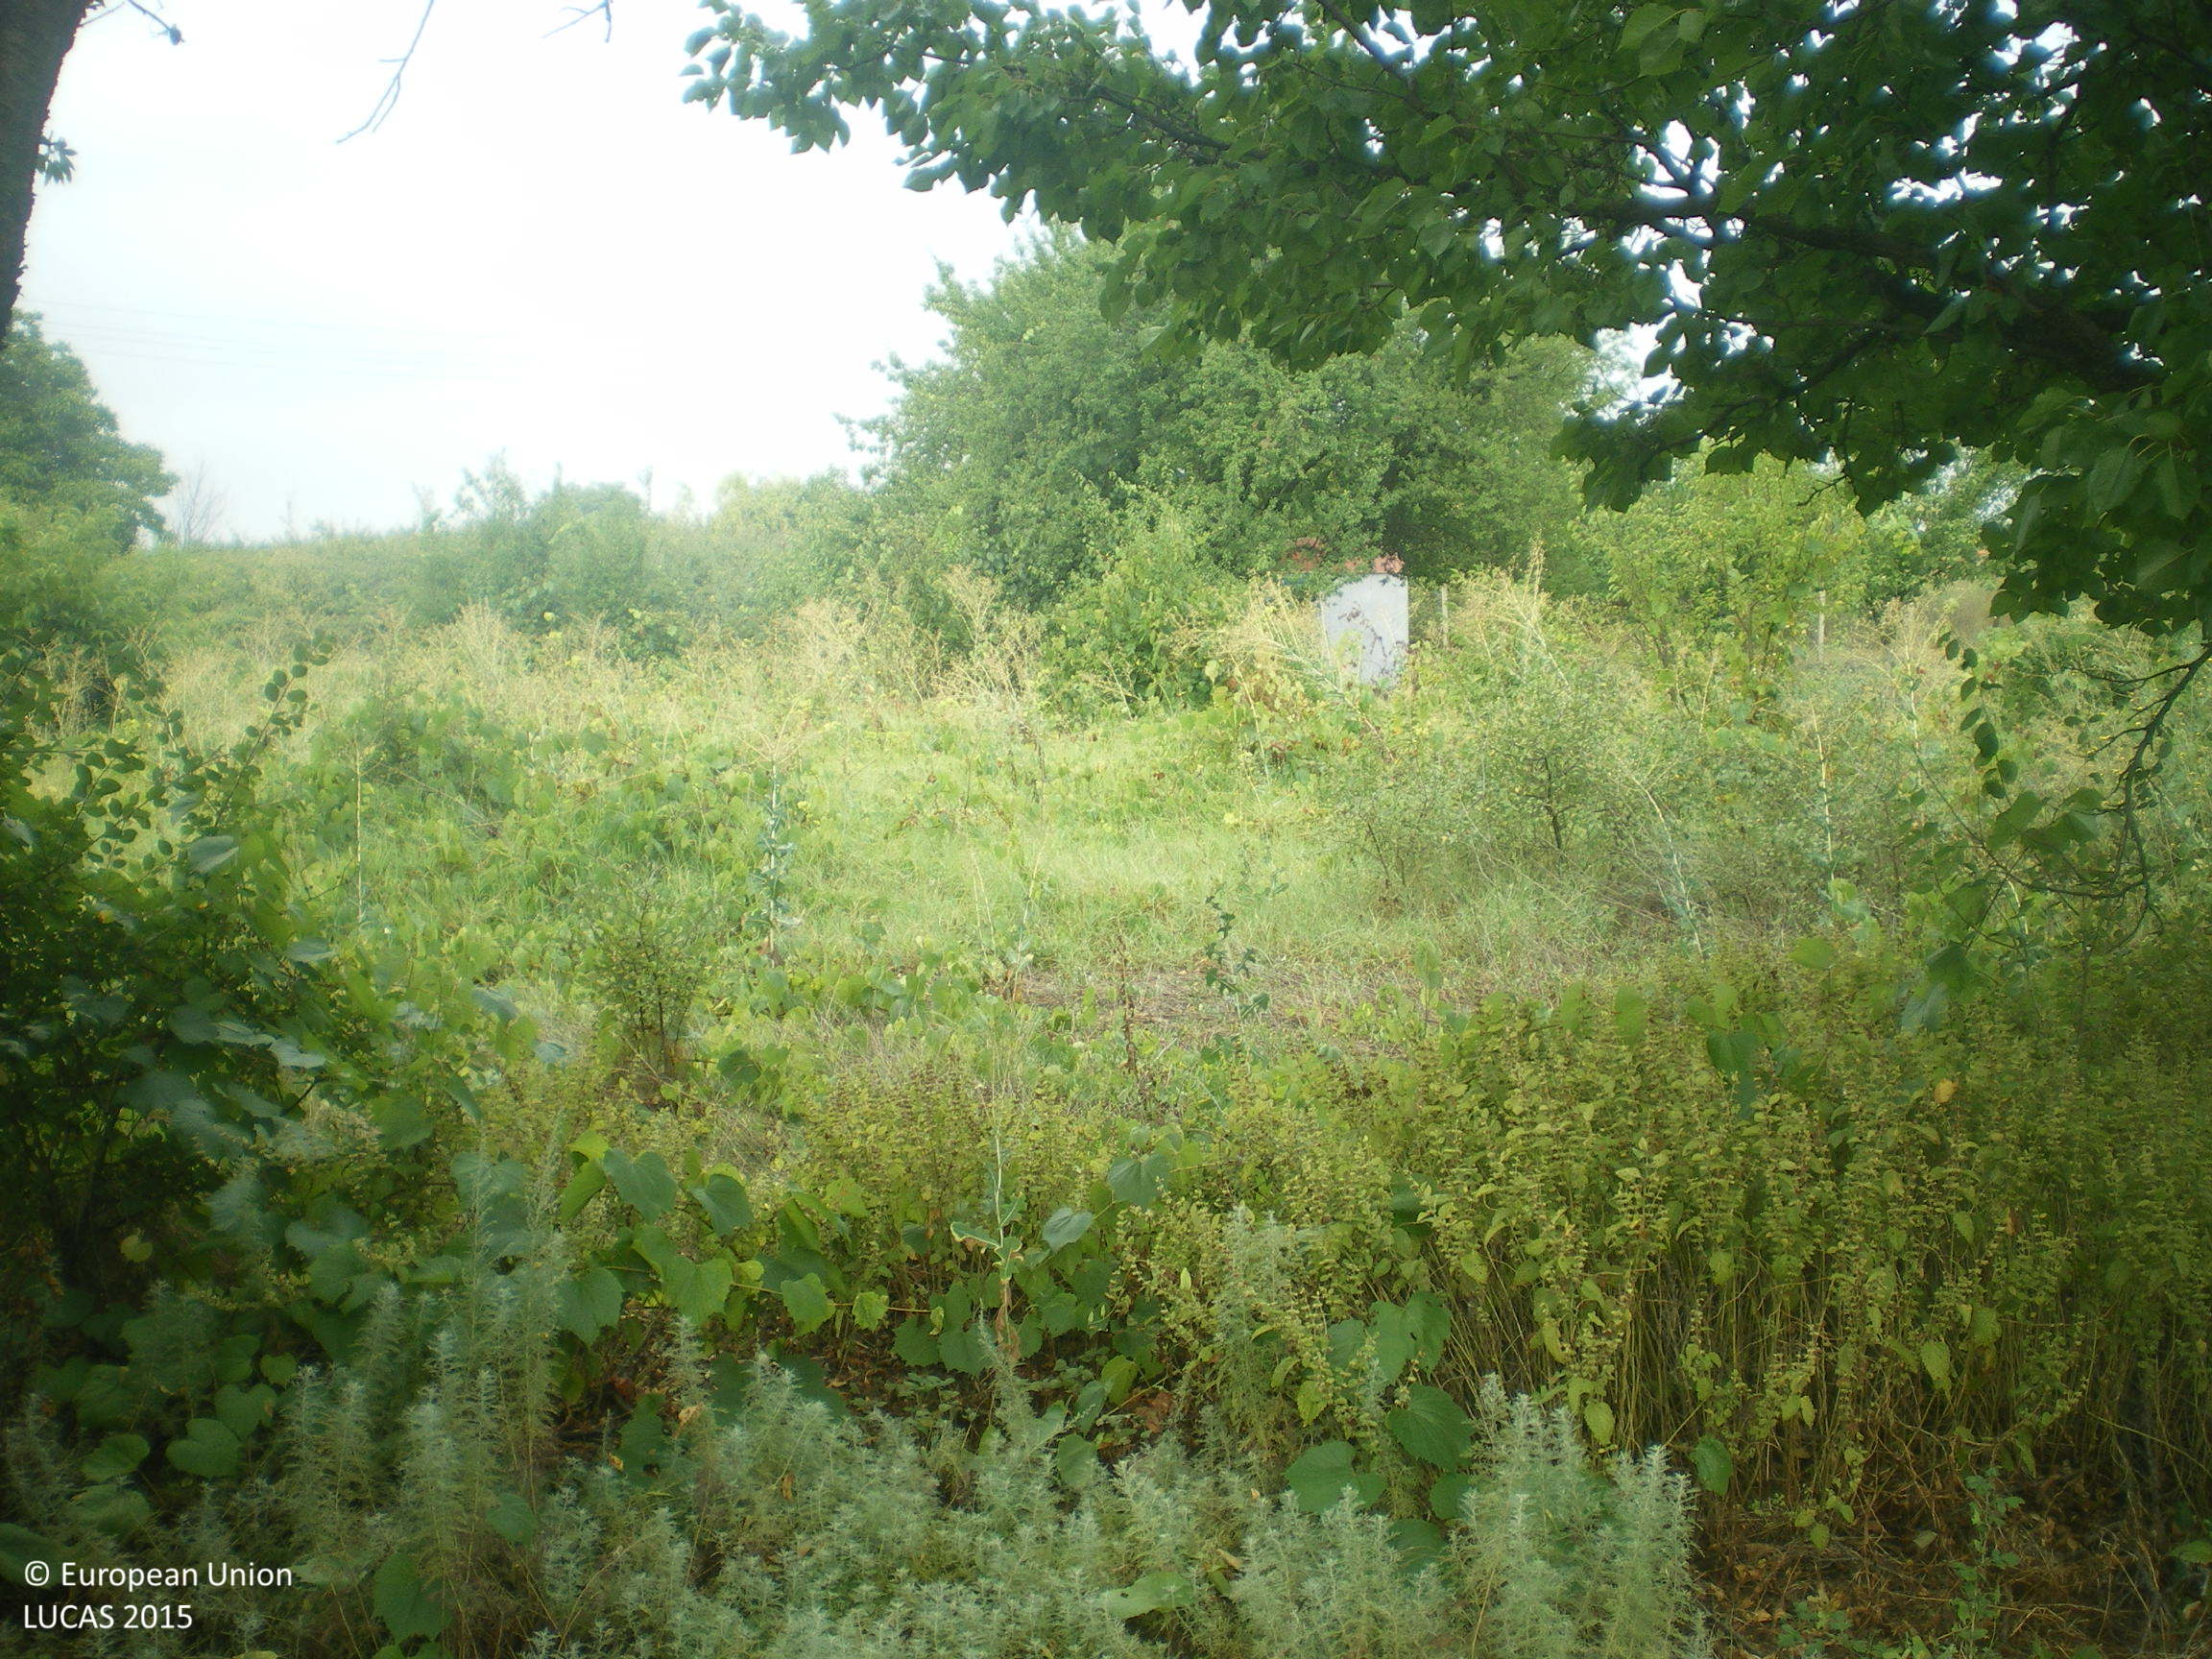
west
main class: Shrubland
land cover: Shrubland with sparse tree cover
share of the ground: 50 - 75 %
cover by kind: shrubs 55 %, herbaceous plants 40 %, broadleaved forest trees 5 %
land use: Fallow land
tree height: > 5 m
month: August
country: BG
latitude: 42.3022
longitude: 25.9312
